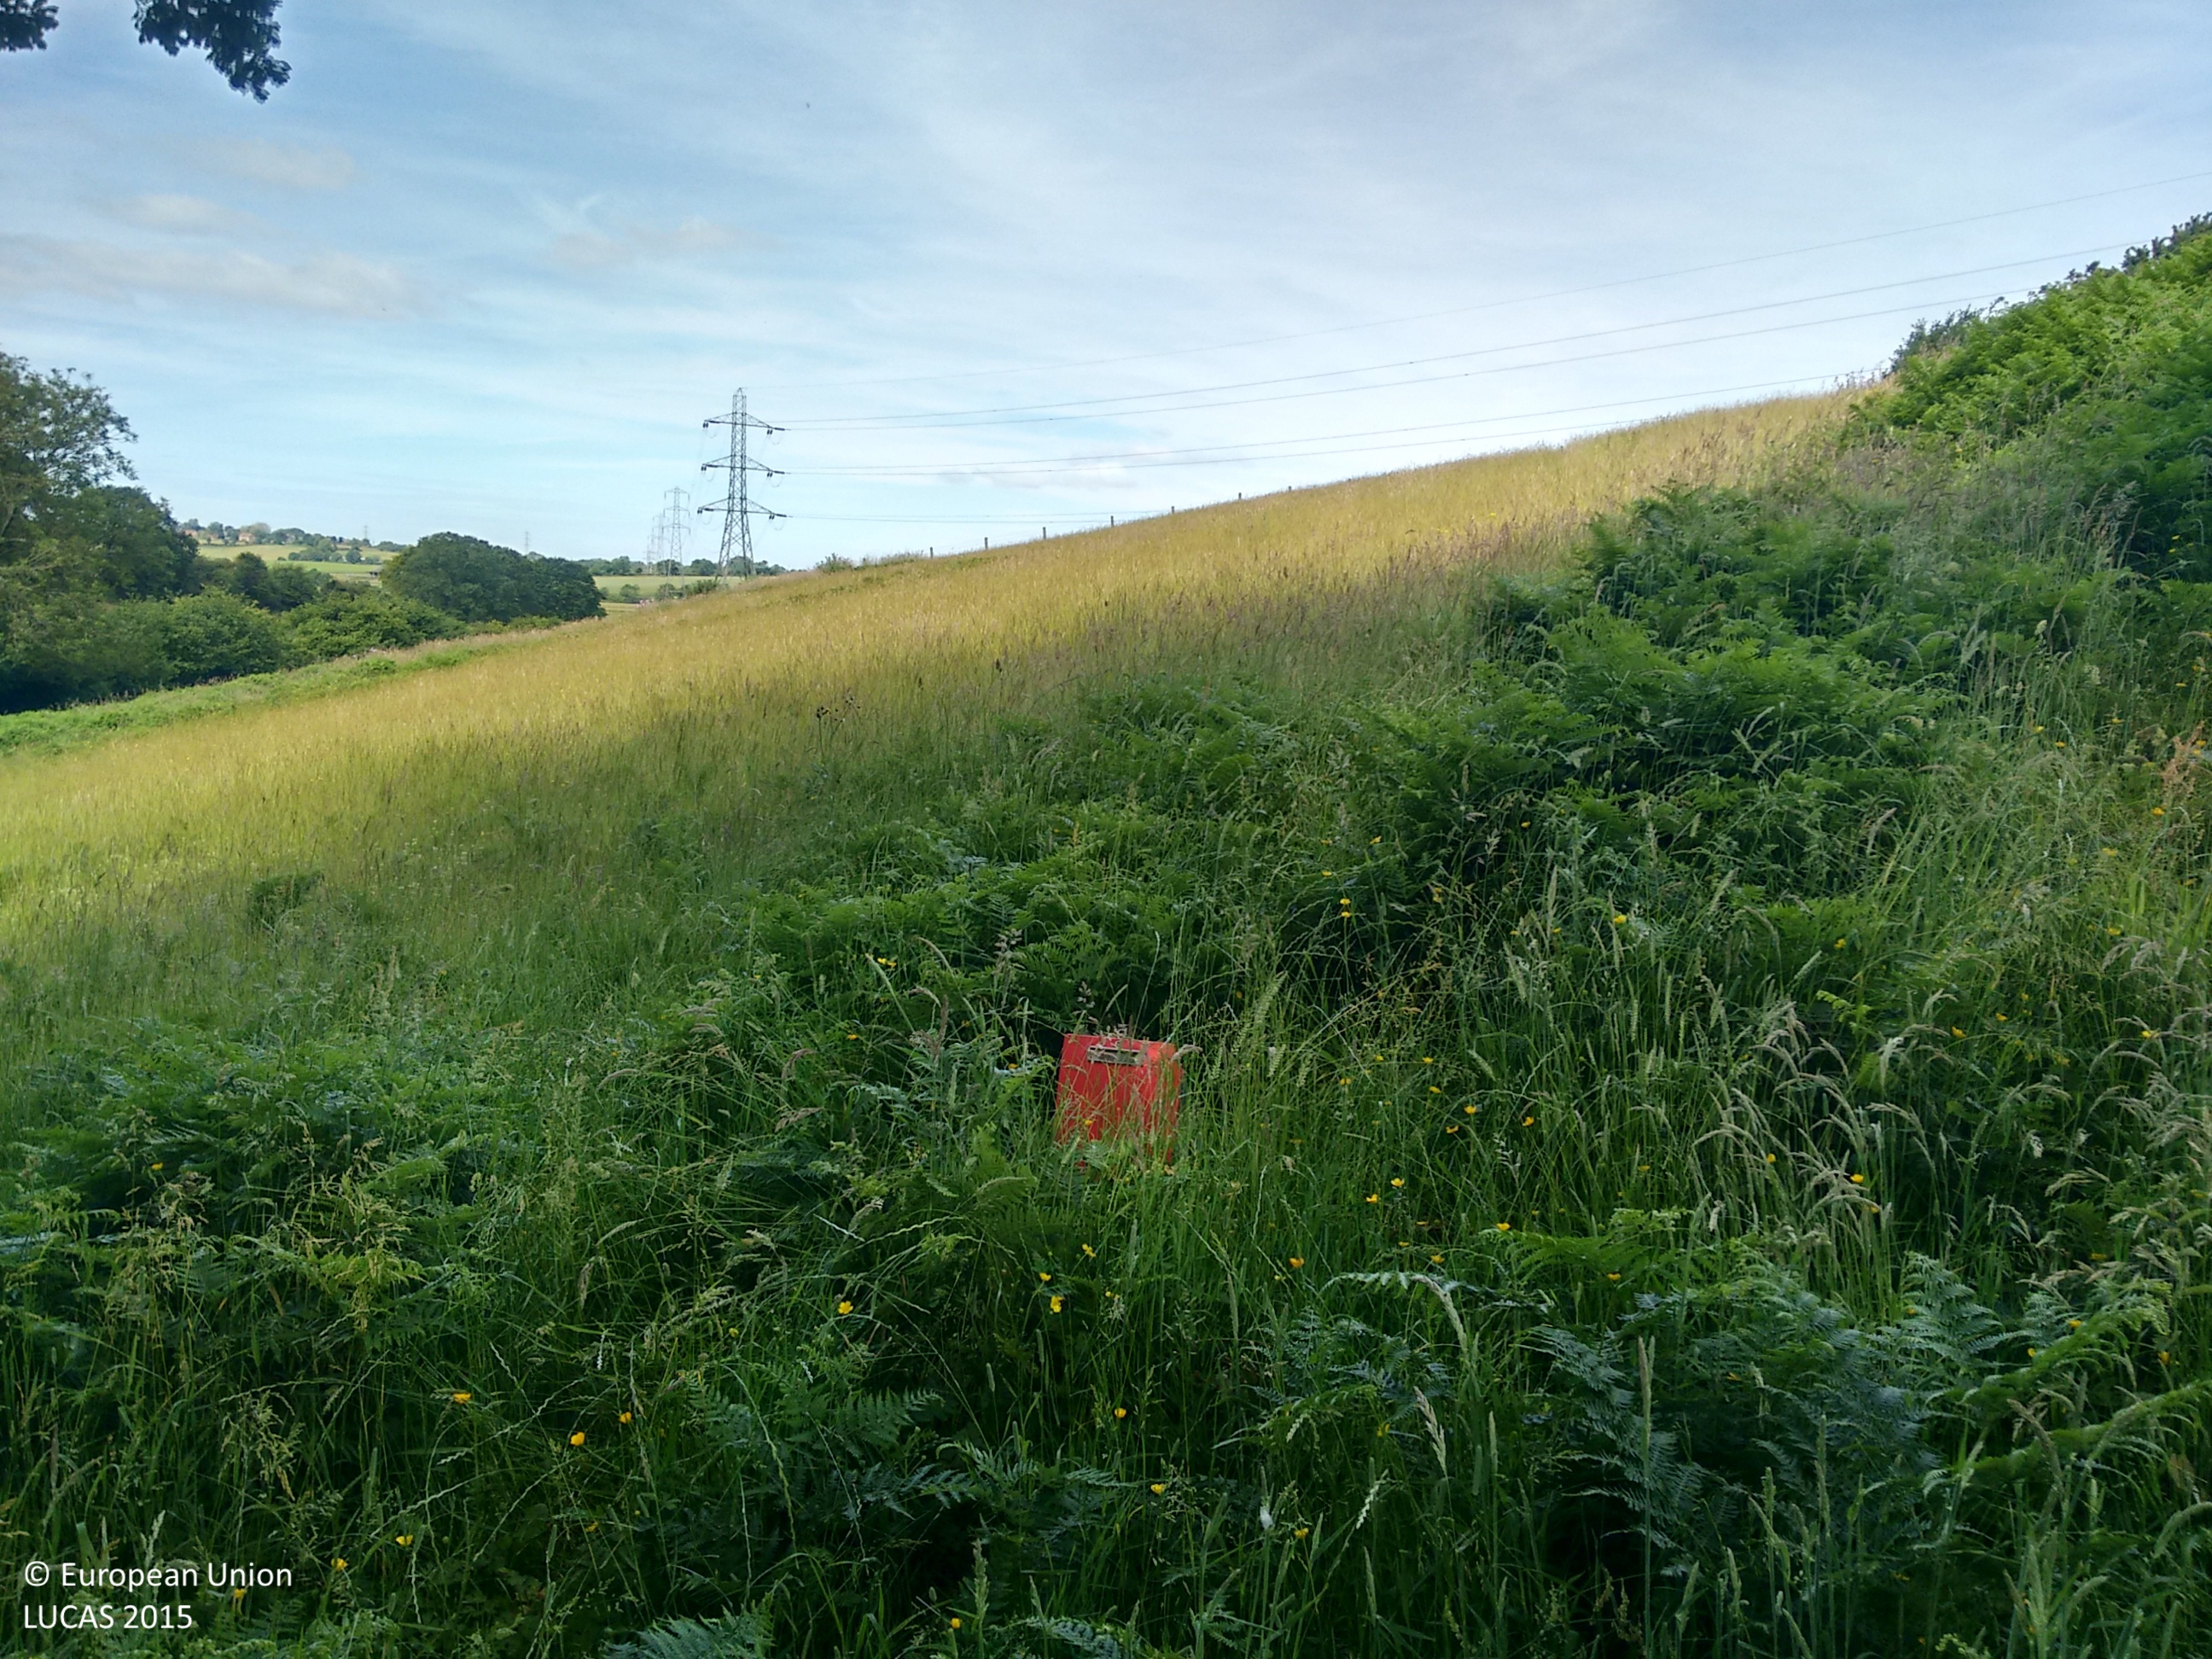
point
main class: Grassland
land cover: Grassland with sparse tree/shrub cover
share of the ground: > 75 %
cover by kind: herbaceous plants 85 %, shrubs 10 %, broadleaved forest trees 5 %
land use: Agriculture (excluding fallow land and kitchen gardens)
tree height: > 5 m
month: June
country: GB
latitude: 50.8633
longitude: 0.3808
